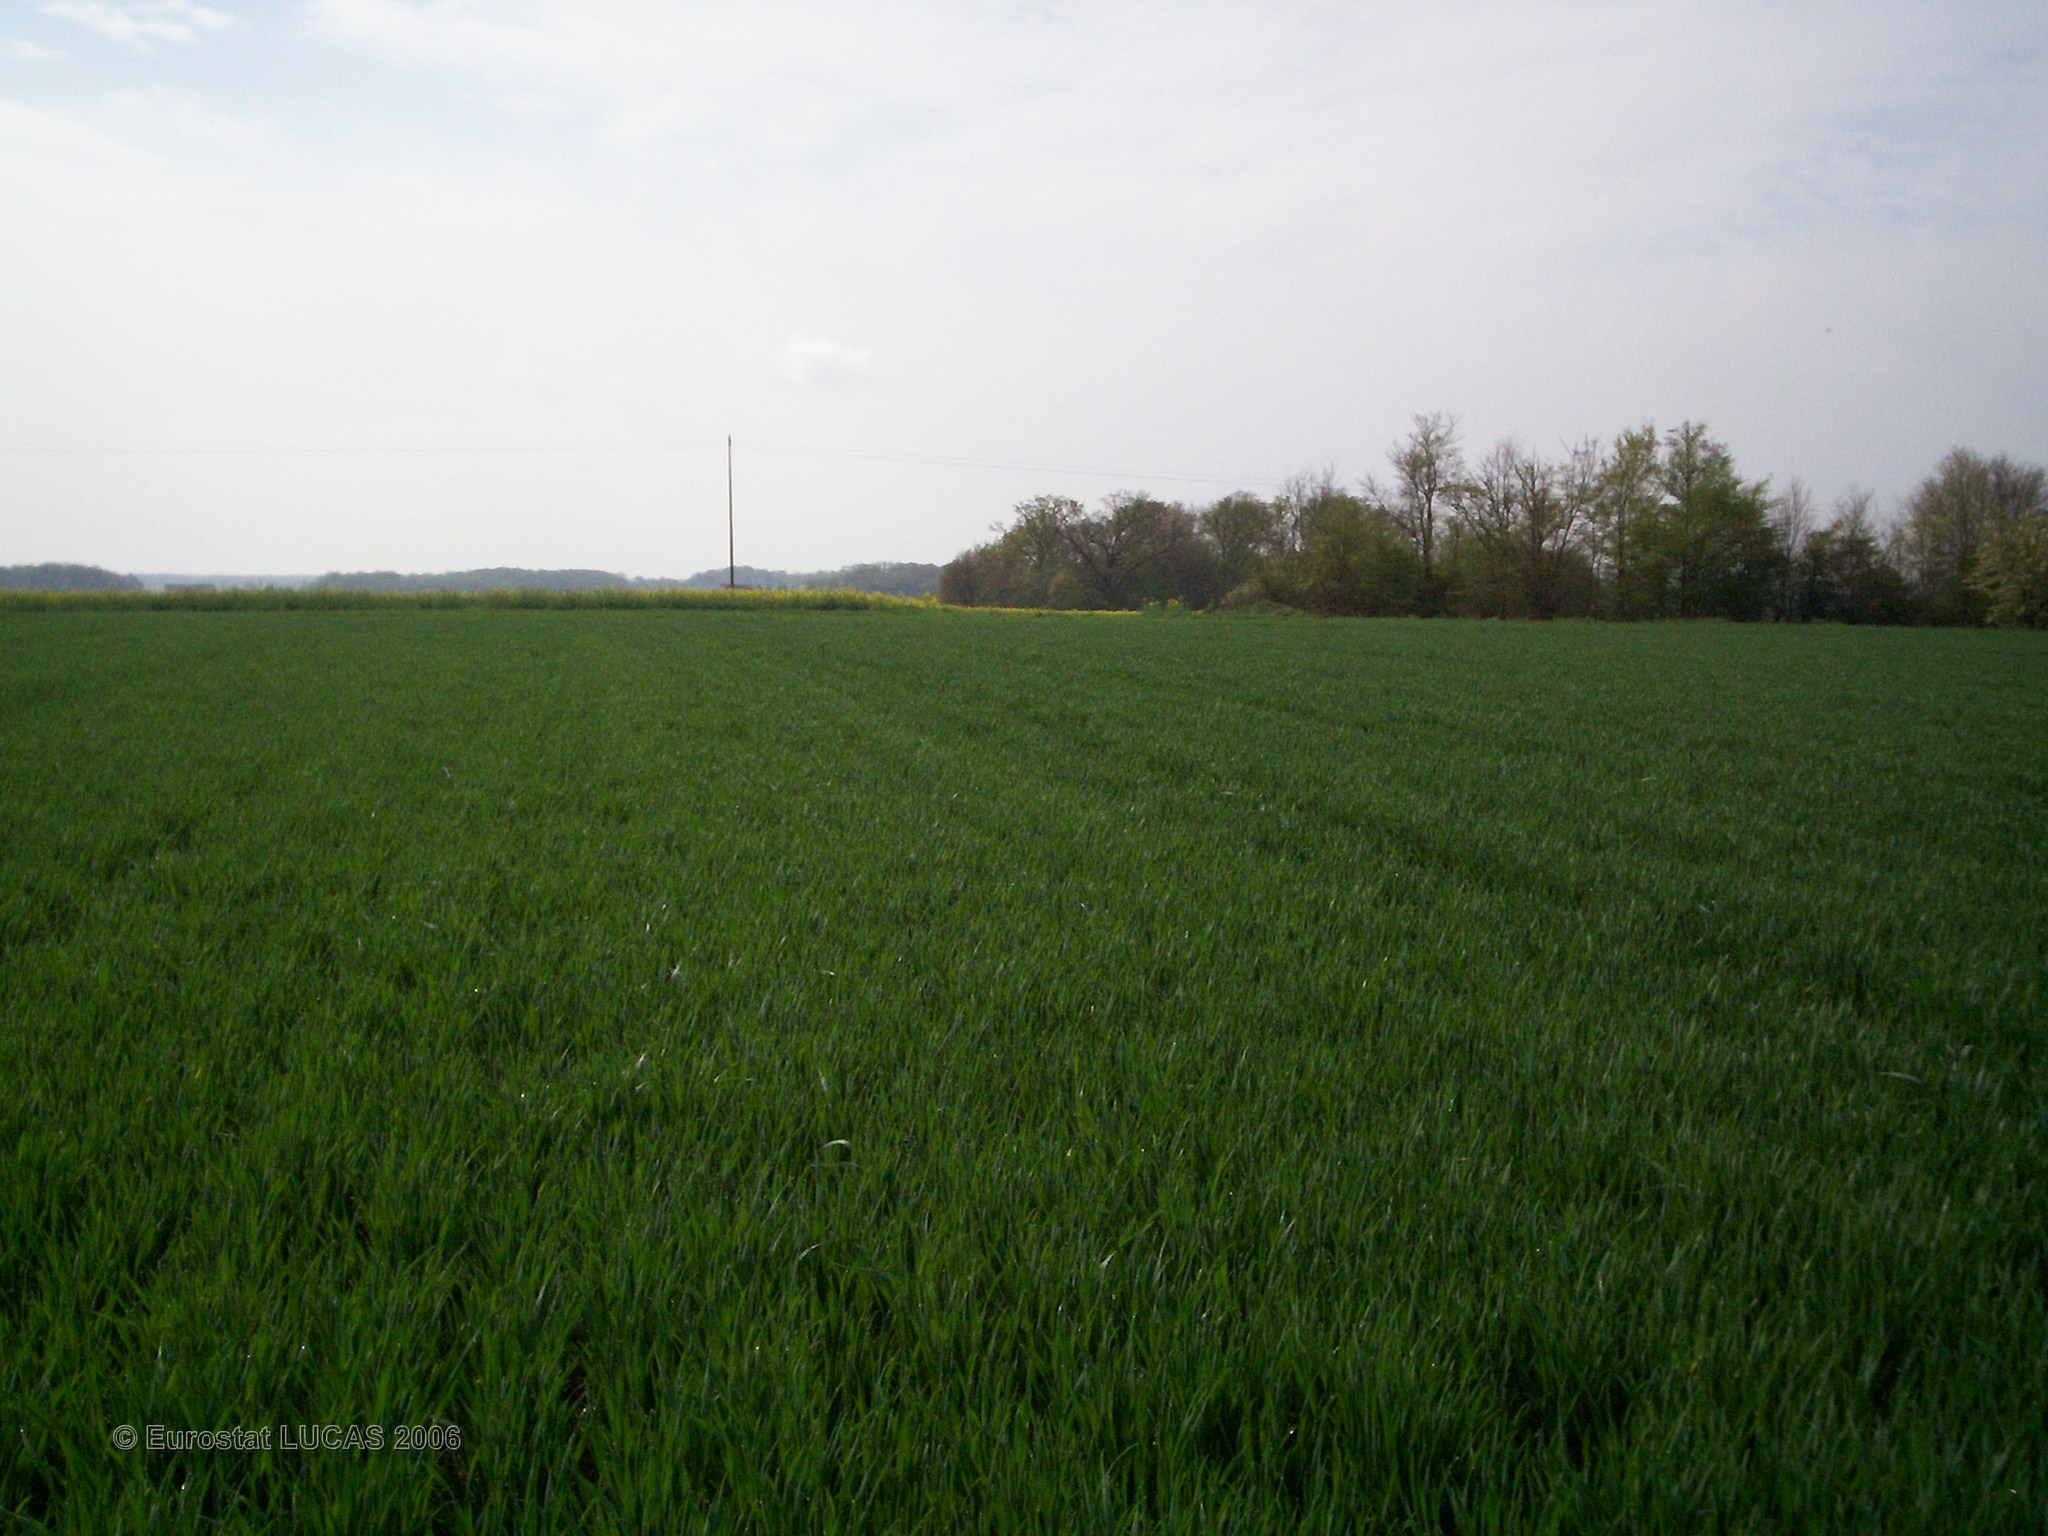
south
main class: Cropland
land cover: Common wheat
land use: Agriculture (excluding fallow land and kitchen gardens)
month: April
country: FR
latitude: 47.8532
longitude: 2.9498
